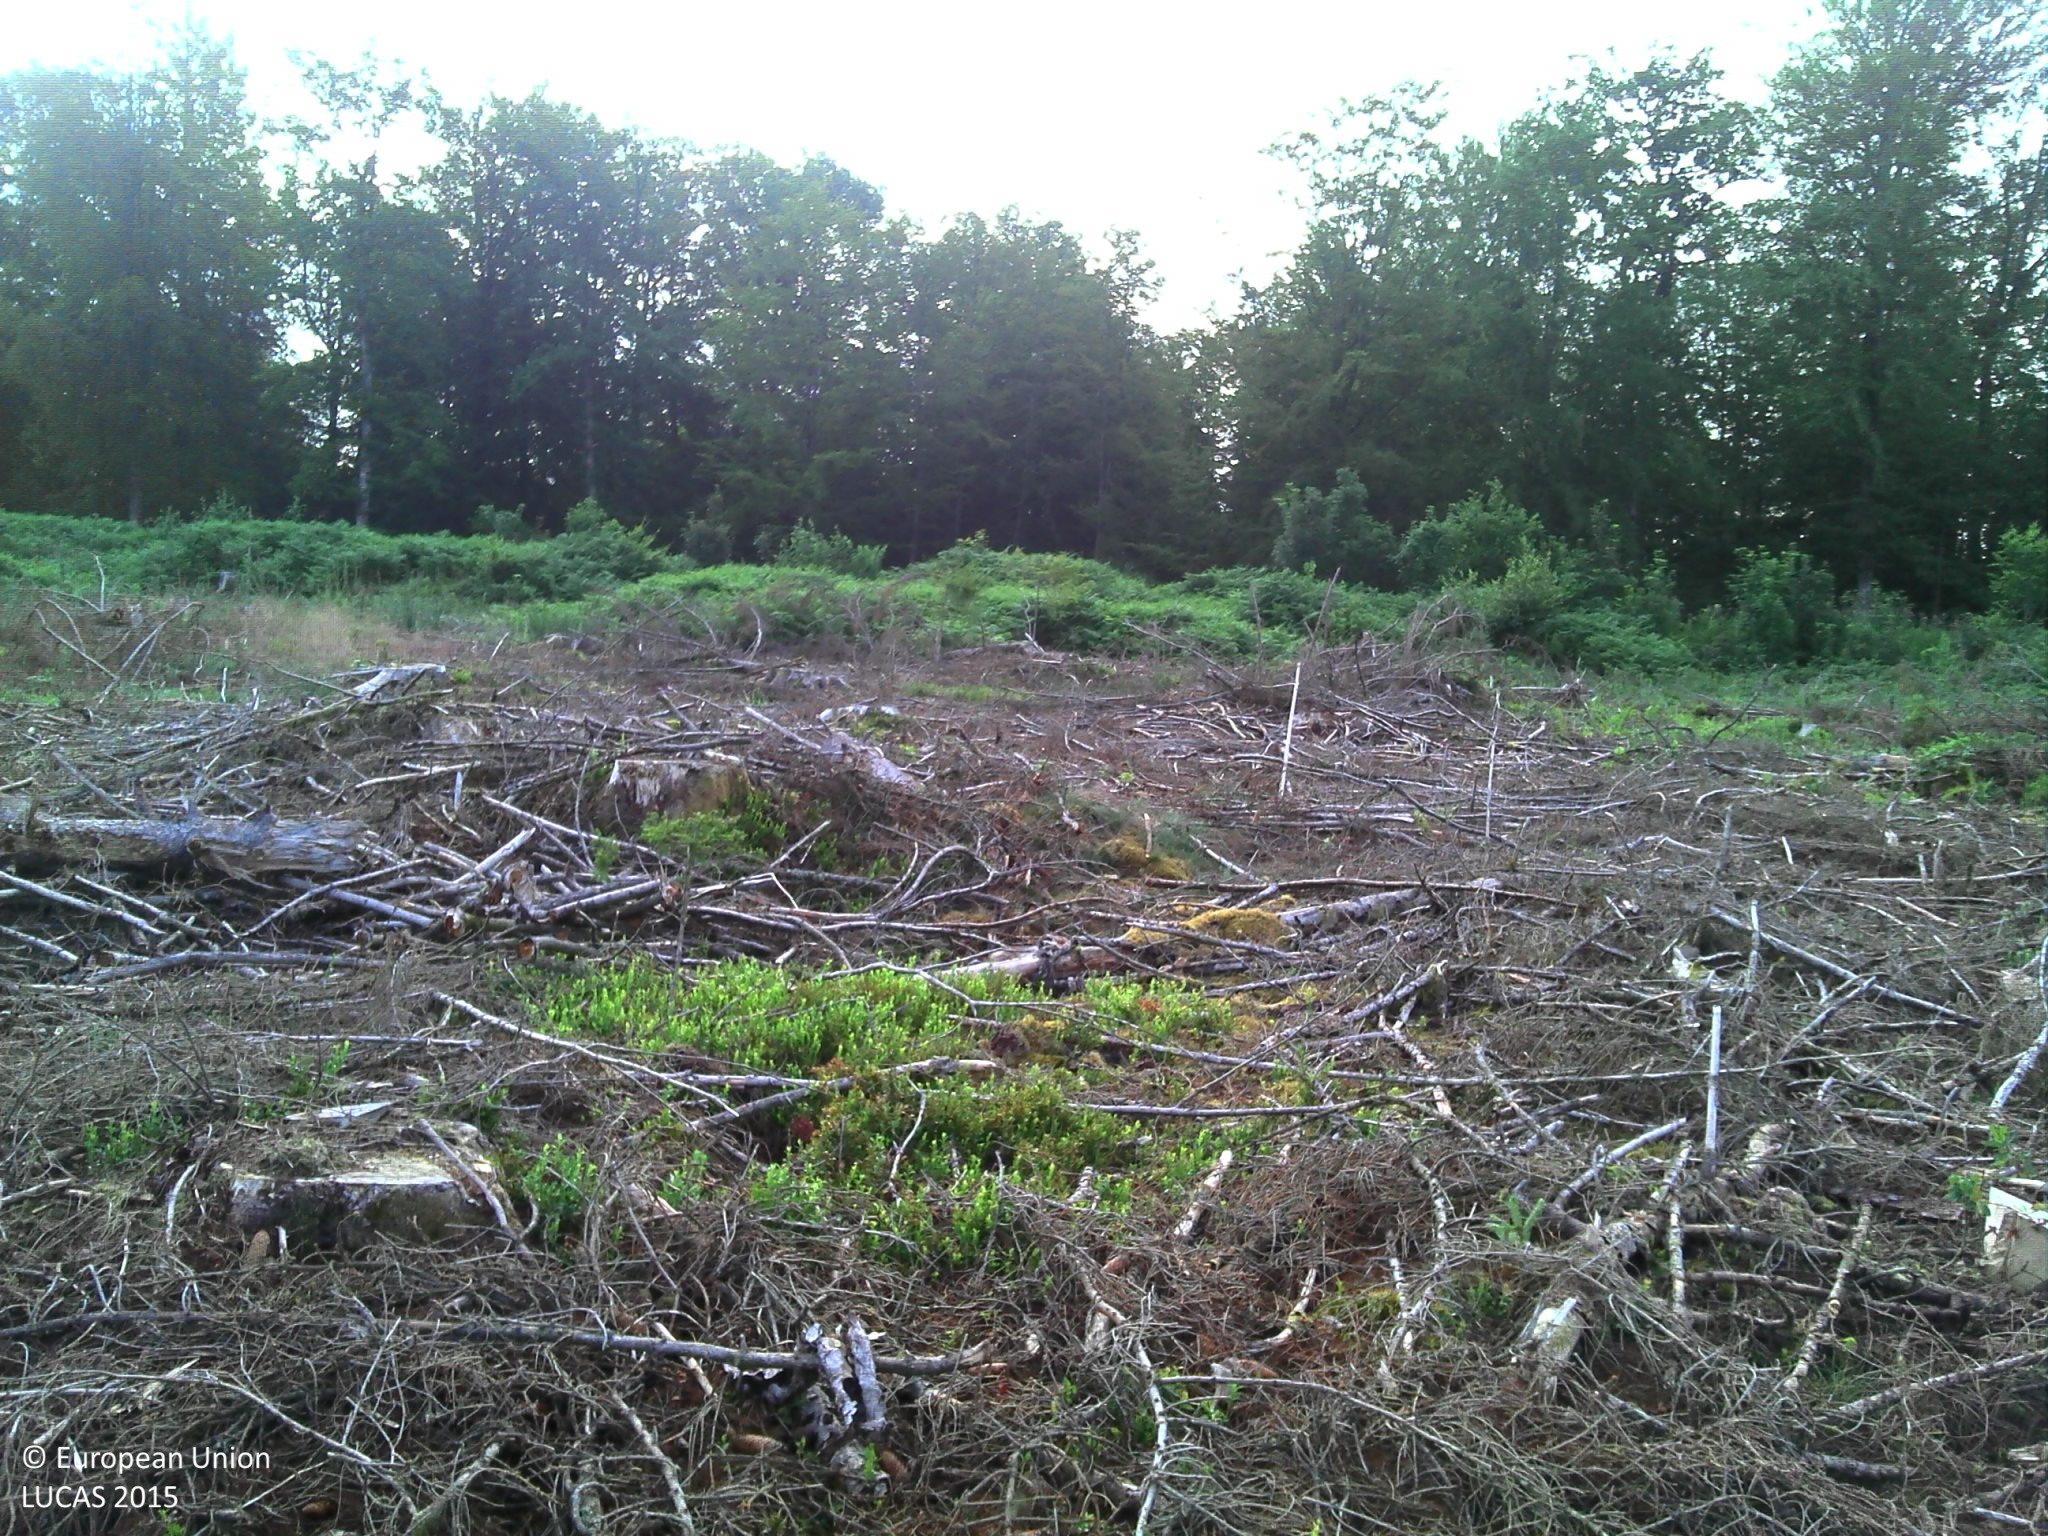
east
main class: Grassland
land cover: Spontaneously vegetated surfaces
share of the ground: 50 - 75 %
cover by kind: herbaceous plants 65 %, unconsolidated bare surface 30 %, shrubs 5 %
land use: Forestry
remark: Clear cut
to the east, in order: Spontaneously vegetated surfaces; Shrubland with sparse tree cover; Grass margins; Paved roads, cycling and walking lanes; Grass margins; Broadleaved woodland; Tracks; Broadleaved woodland
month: July
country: BE
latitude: 49.7639
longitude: 5.3195
